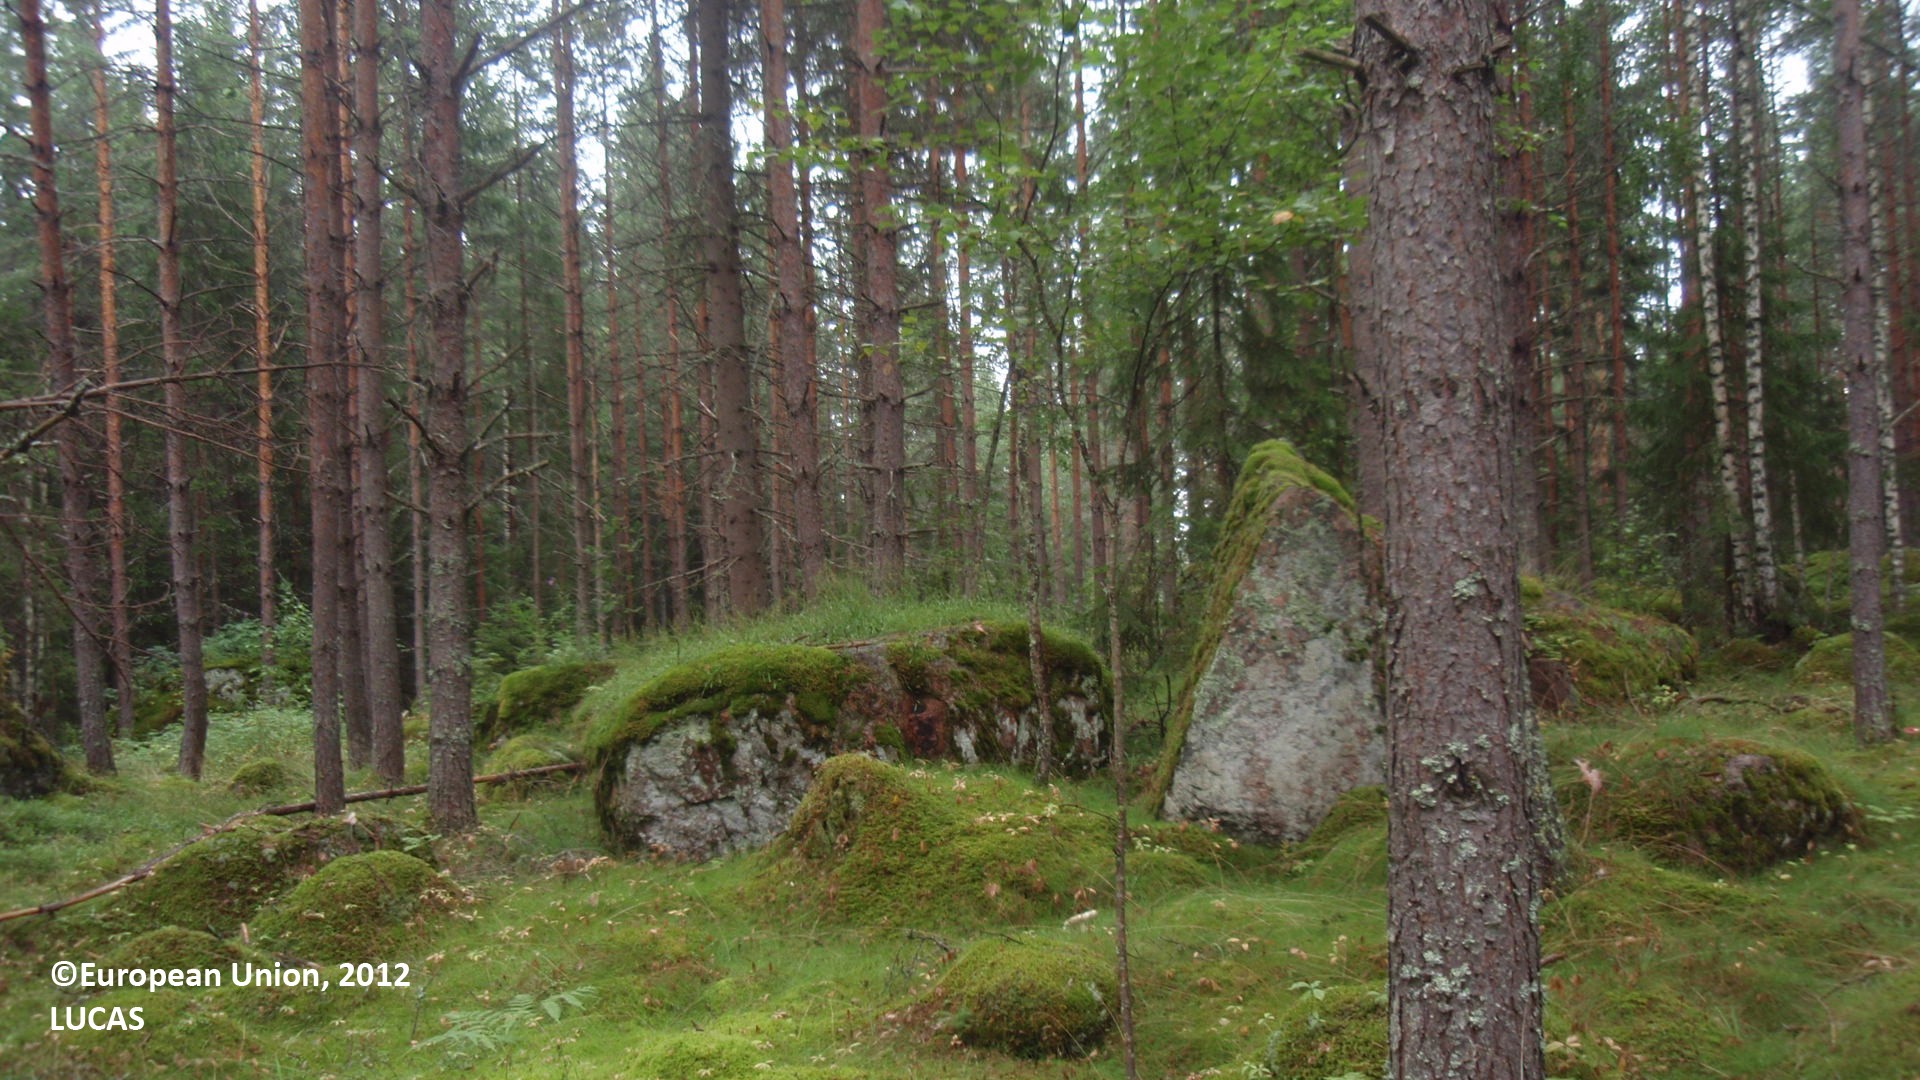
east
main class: Woodland
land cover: Pine dominated mixed woodland
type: boreal forest
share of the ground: 50 - 75 %
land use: Forestry
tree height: > 5 m
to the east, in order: Pine dominated mixed woodland; Spruce dominated mixed woodland; Tracks; Spruce dominated mixed woodland; Electric lines; Grassland without tree/shrub cover
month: August
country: FI
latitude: 60.6020
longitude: 26.6510
